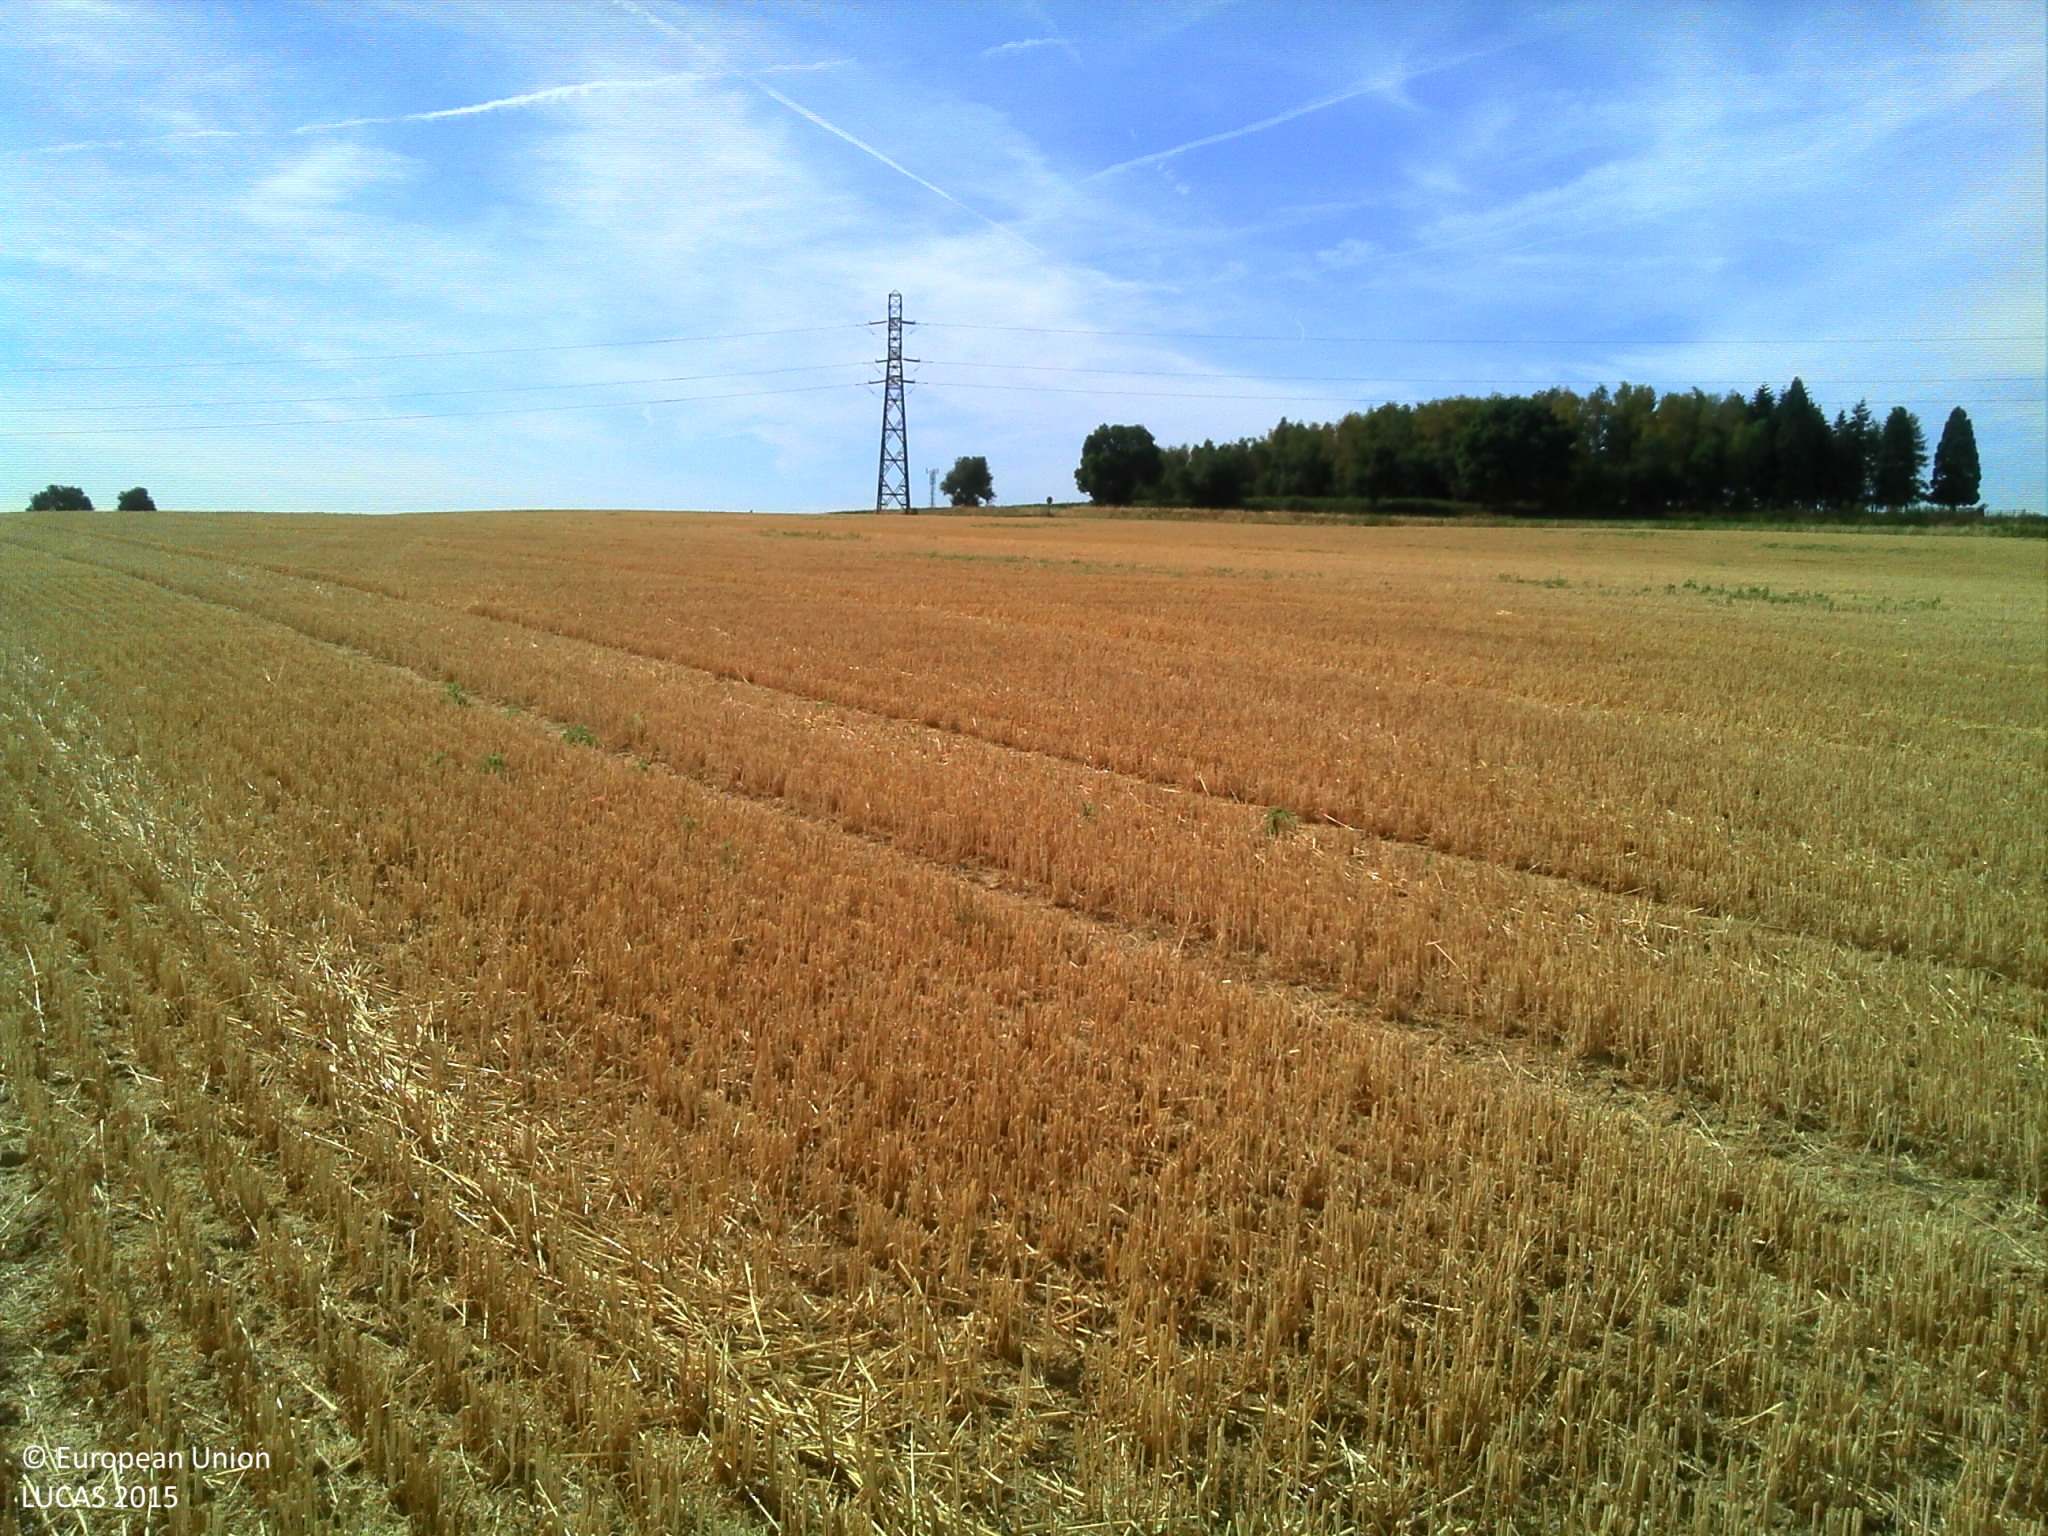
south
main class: Cropland
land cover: Common wheat
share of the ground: 10 - 25 %
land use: Agriculture (excluding fallow land and kitchen gardens)
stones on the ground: < 10 %
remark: Harvested field
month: August
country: FR
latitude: 49.0595
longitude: 2.6128
